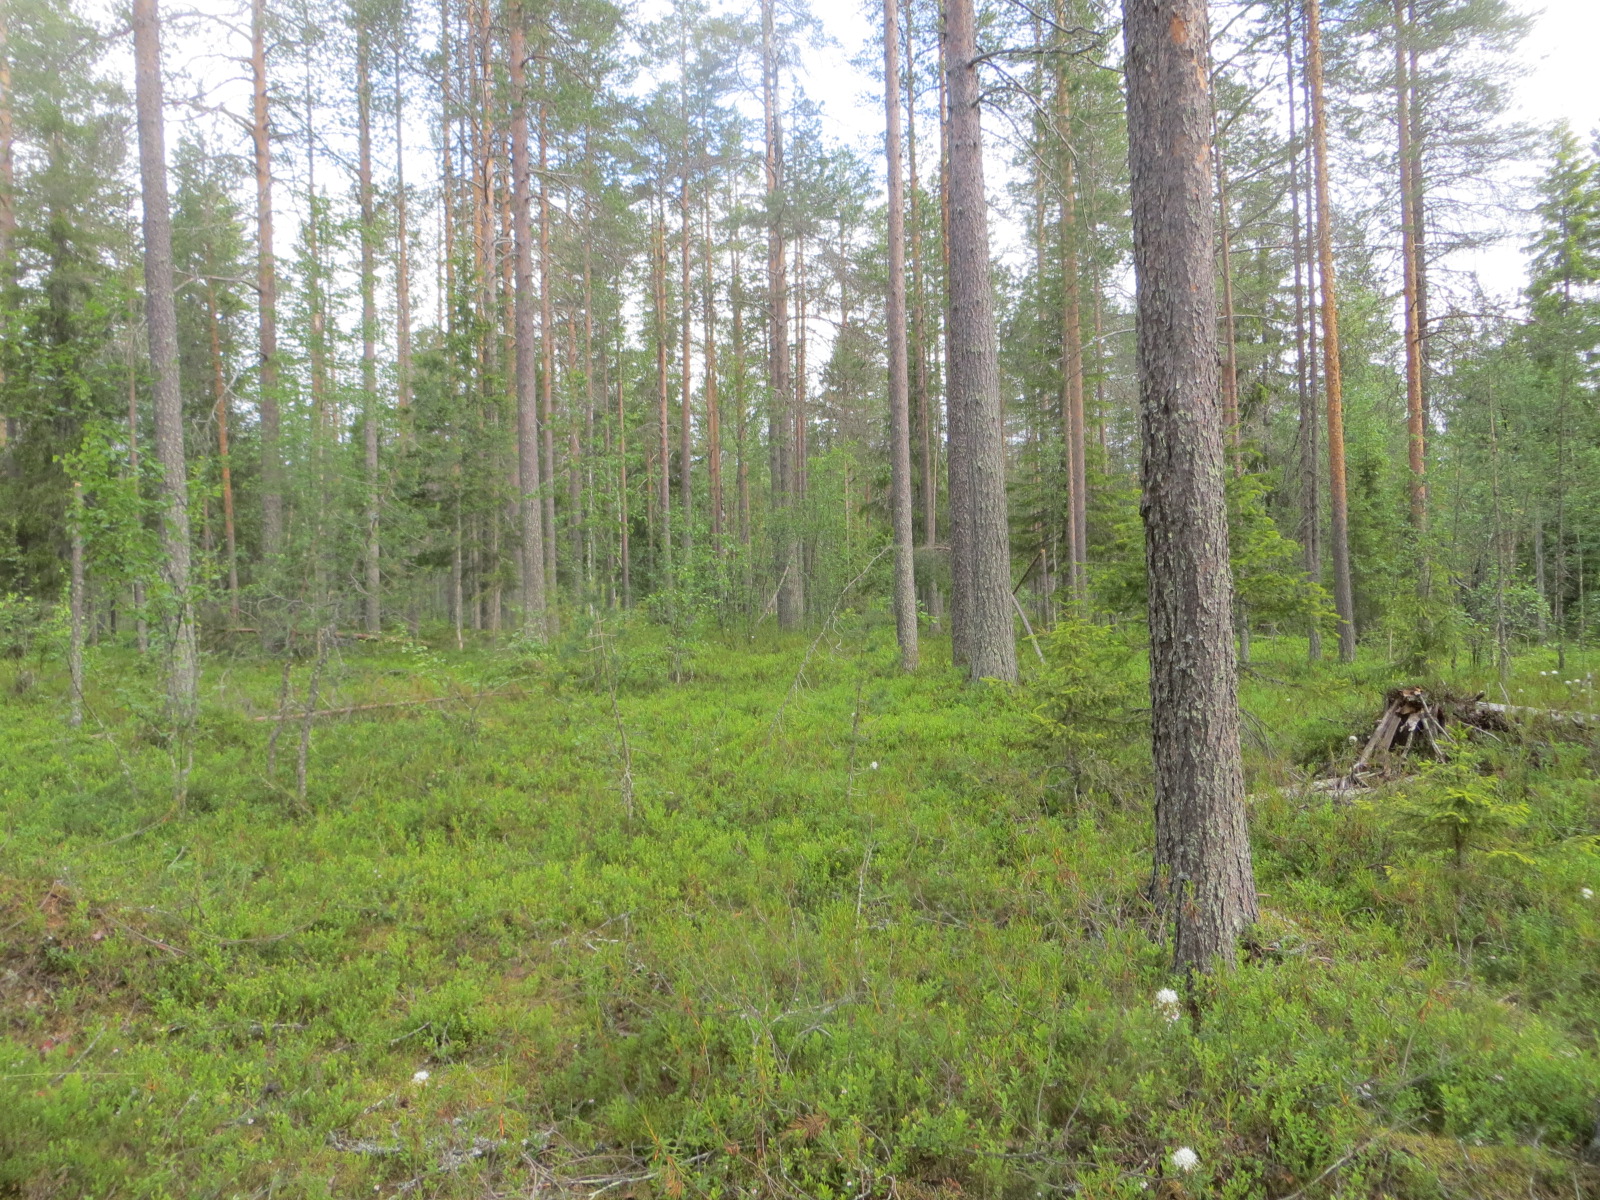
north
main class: Woodland
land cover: Pine dominated coniferous woodland
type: boreal forest
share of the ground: 50 - 75 %
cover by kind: coniferous forest trees 50 %, shrubs 45 %, broadleaved forest trees 5 %
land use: Forestry
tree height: > 5 m
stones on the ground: 25 - 50 %
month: July
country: FI
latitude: 66.3315
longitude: 25.9024
